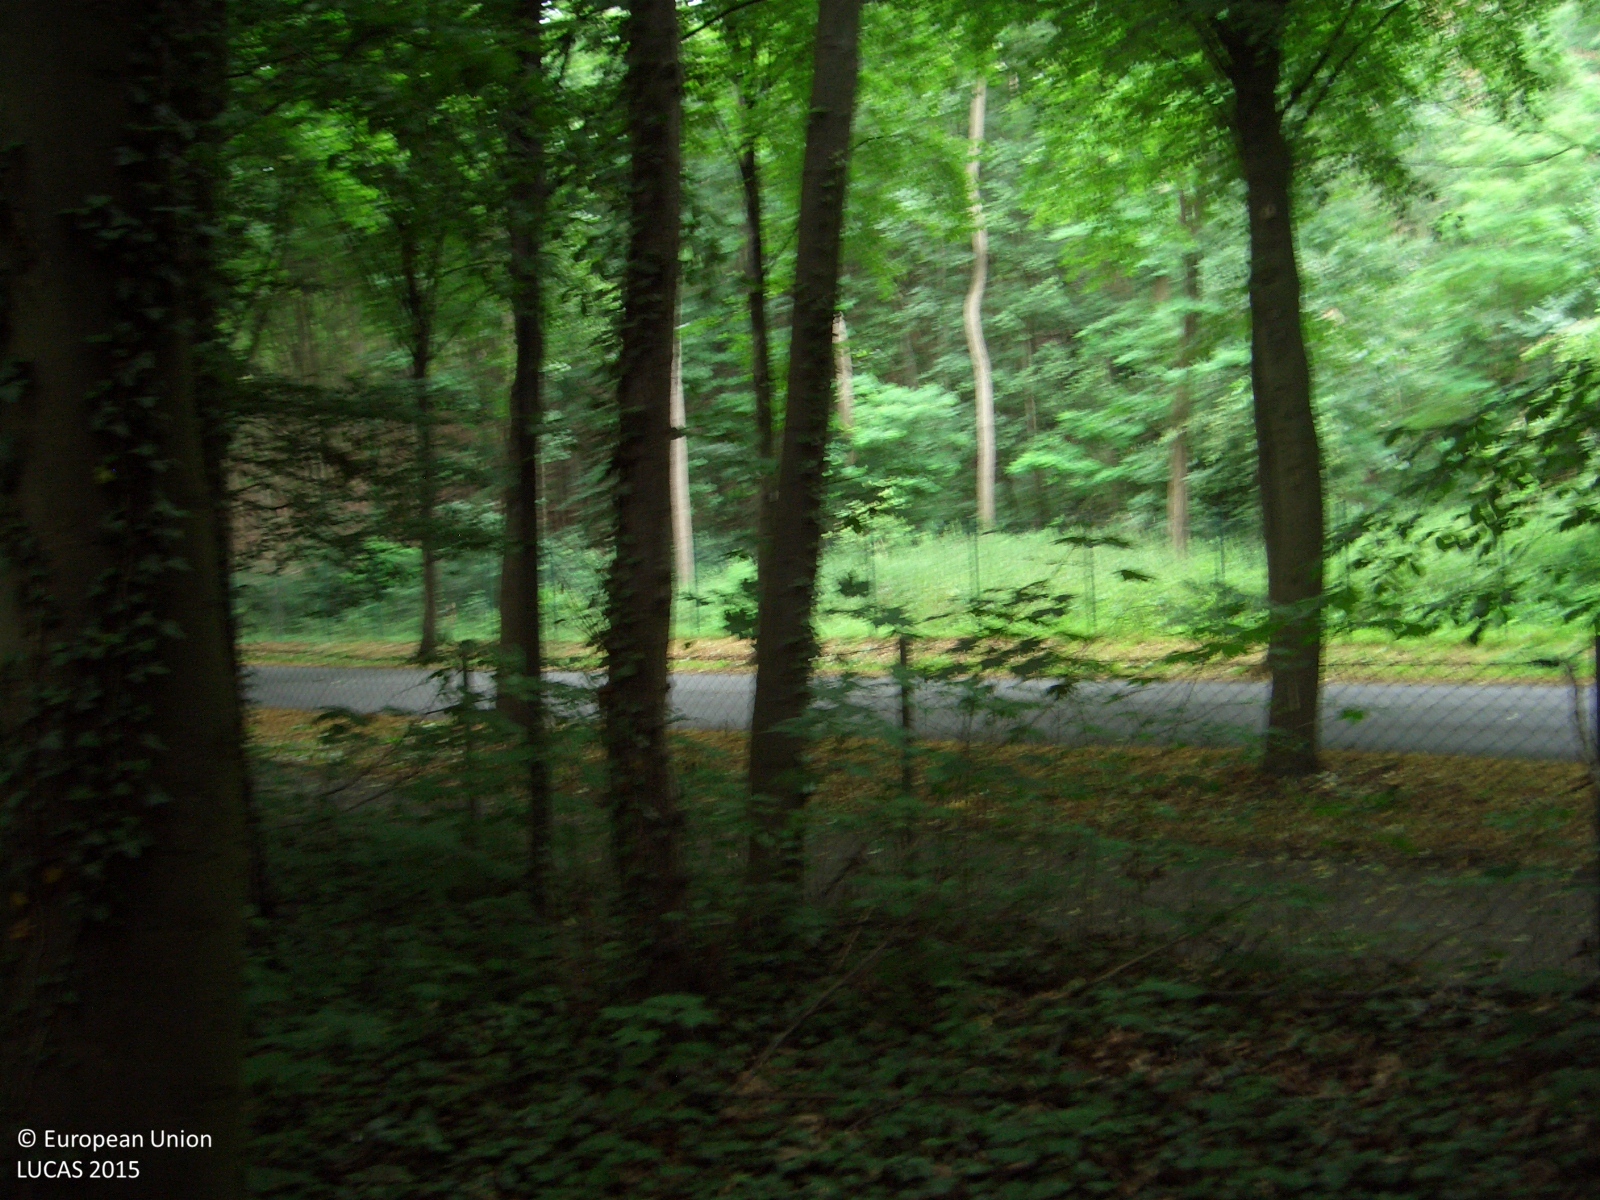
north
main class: Woodland
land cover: Broadleaved woodland
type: mesophytic deciduous forest
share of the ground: > 75 %
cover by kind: broadleaved forest trees 100 %
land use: Energy production
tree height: > 5 m
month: July
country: DE
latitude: 51.6024
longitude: 7.0114
